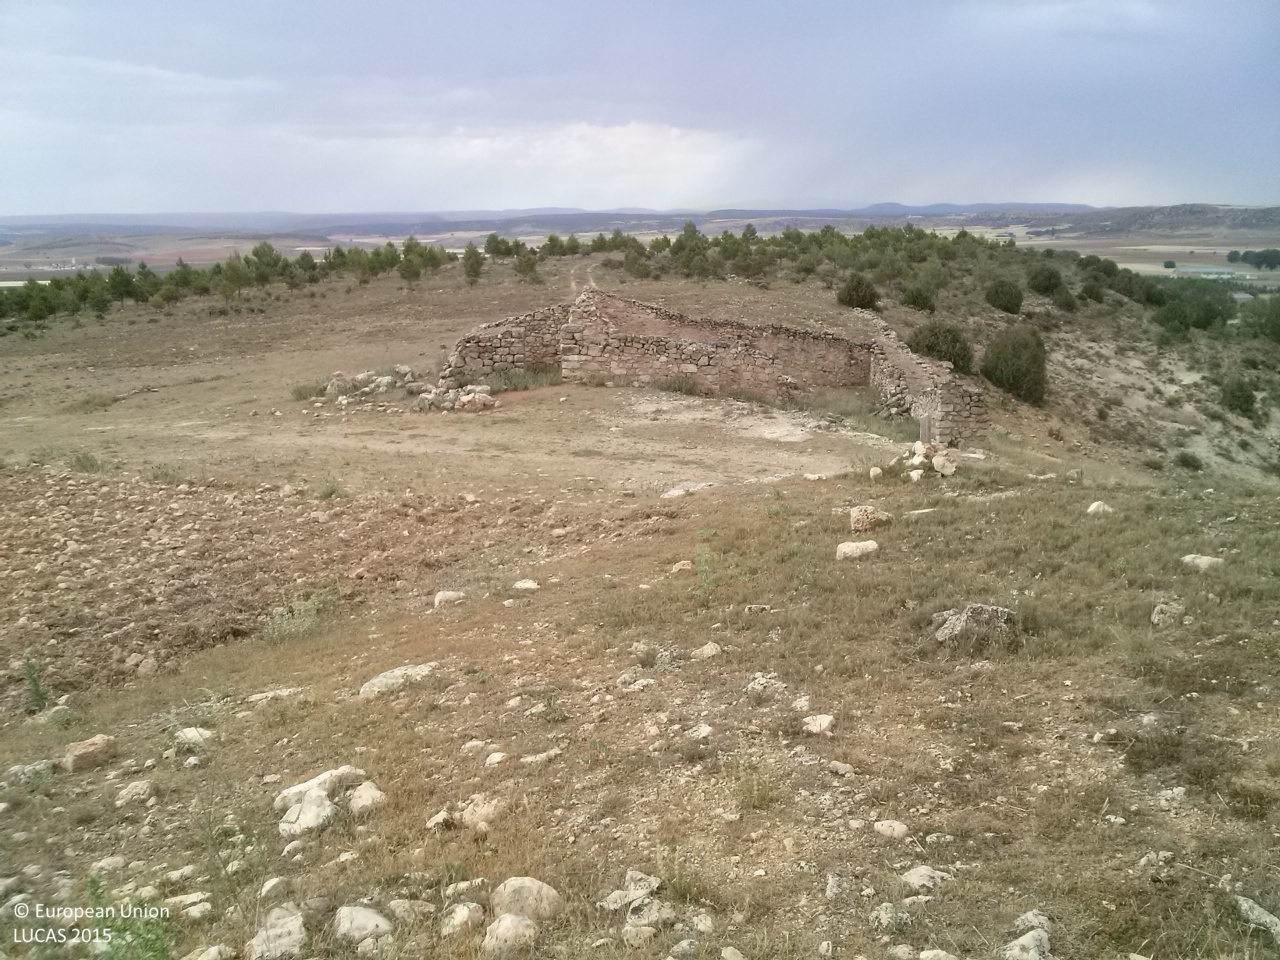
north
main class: Grassland
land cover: Grassland without tree/shrub cover
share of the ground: > 75 %
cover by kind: herbaceous plants 80 %, consolidated bare surface 20 %
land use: Agriculture (excluding fallow land and kitchen gardens)
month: June
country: ES
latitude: 39.8954
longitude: -1.8352
